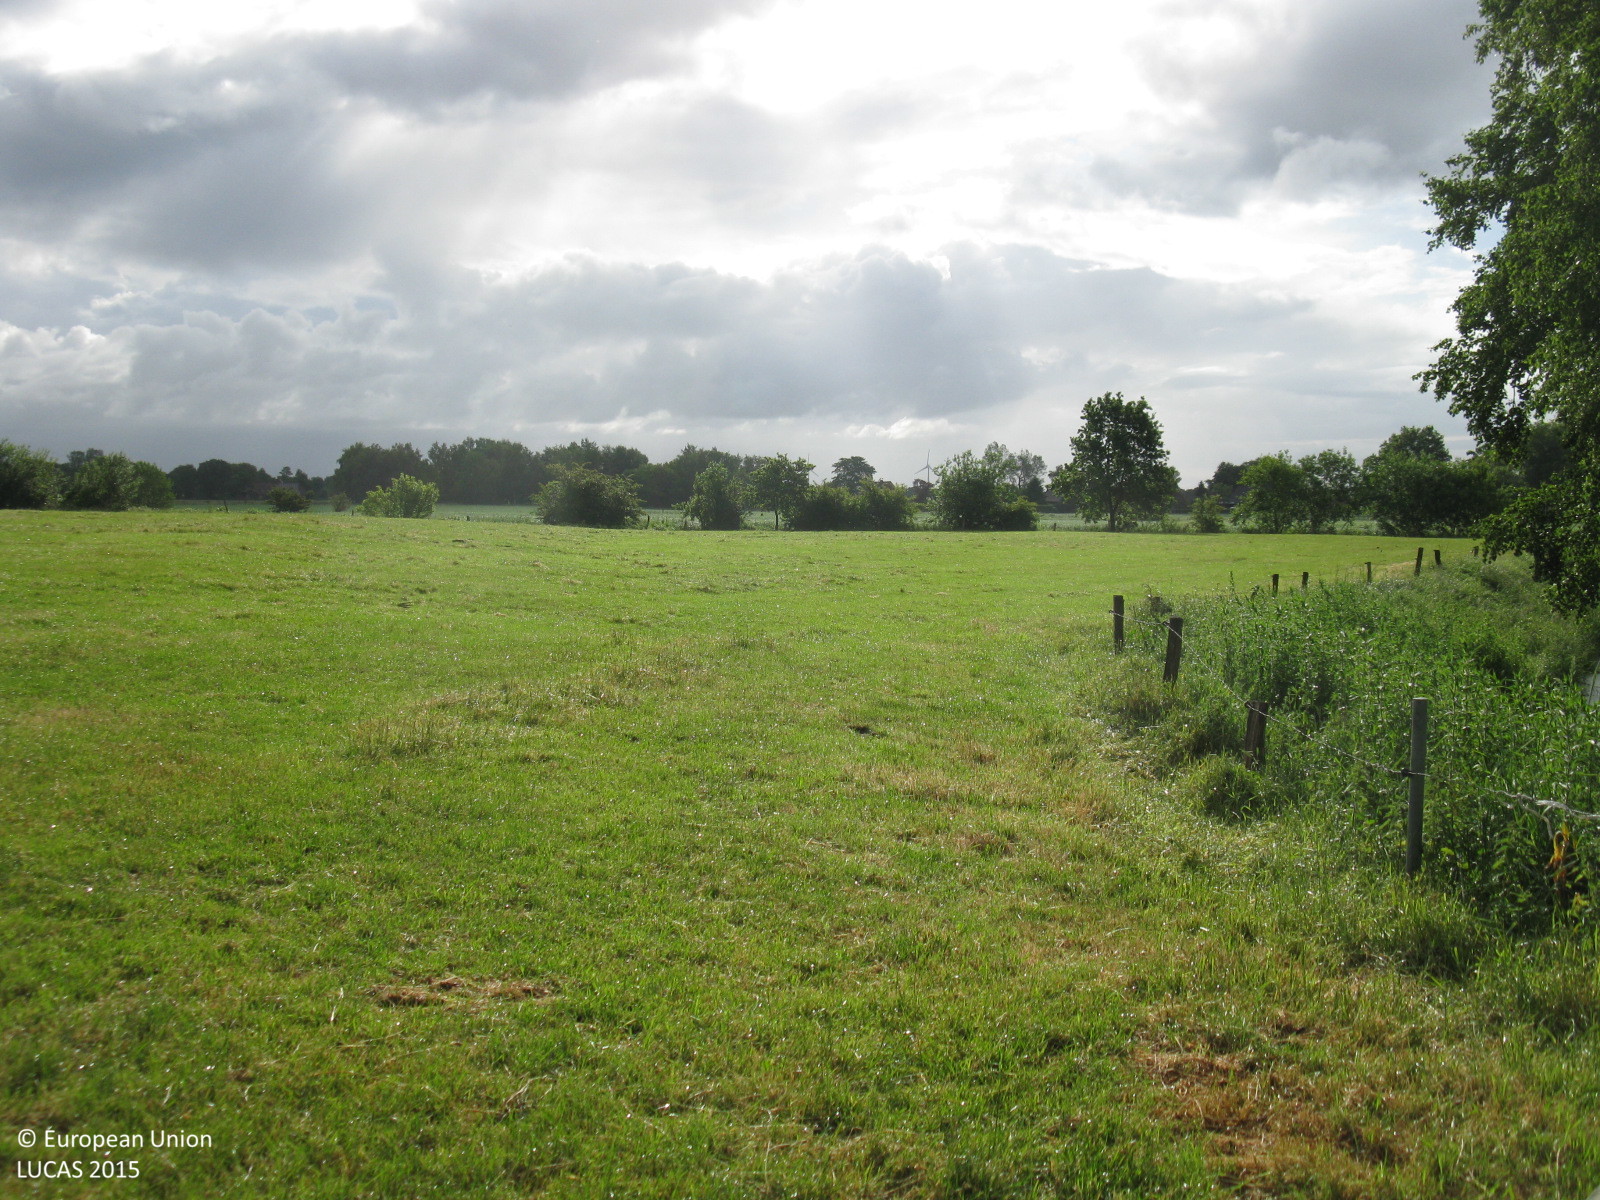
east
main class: Grassland
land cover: Grassland without tree/shrub cover
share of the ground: > 75 %
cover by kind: herbaceous plants 100 %
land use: Agriculture (excluding fallow land and kitchen gardens)
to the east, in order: Grassland without tree/shrub cover; Fences; Broadleaved woodland; Ditches and canals; Temporary grasslands; Fences; Grass margins; Ditches and canals; Grass margins; Fences; Temporary grasslands
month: June
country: DE
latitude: 53.4985
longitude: 7.3324
